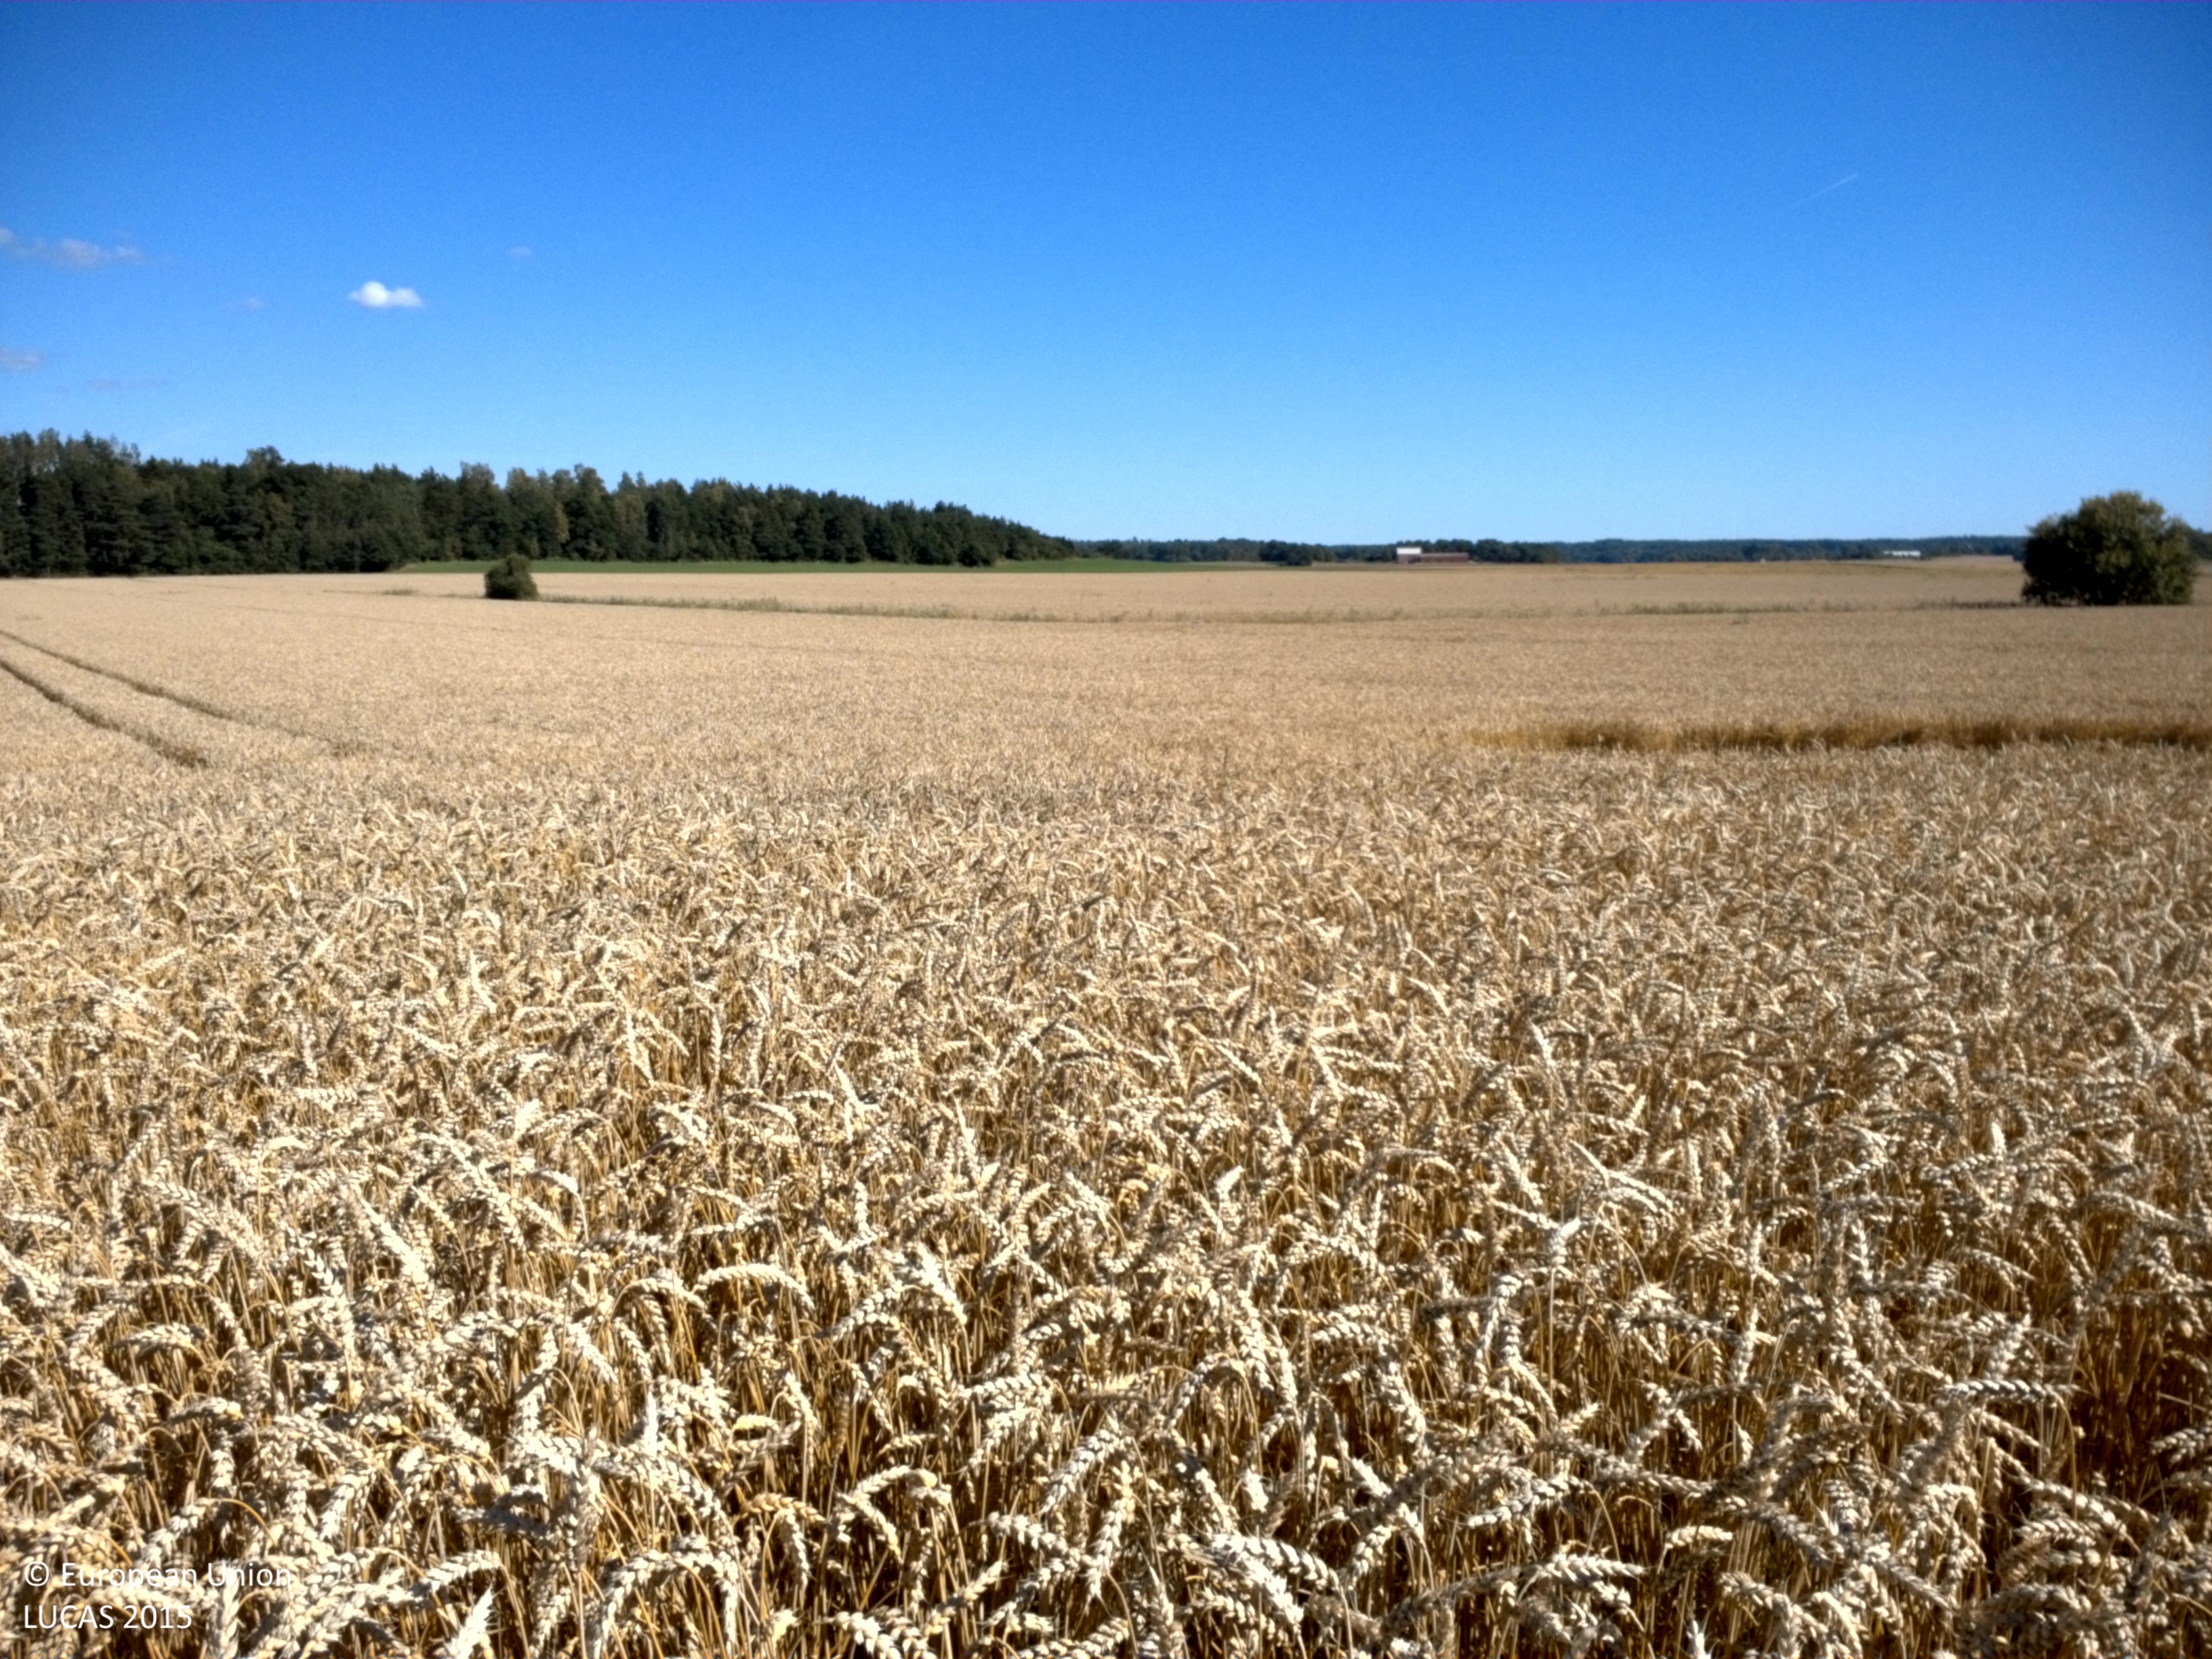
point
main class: Cropland
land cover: Common wheat
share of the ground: > 75 %
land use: Agriculture (excluding fallow land and kitchen gardens)
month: August
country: SE
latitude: 59.7230
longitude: 17.5876
